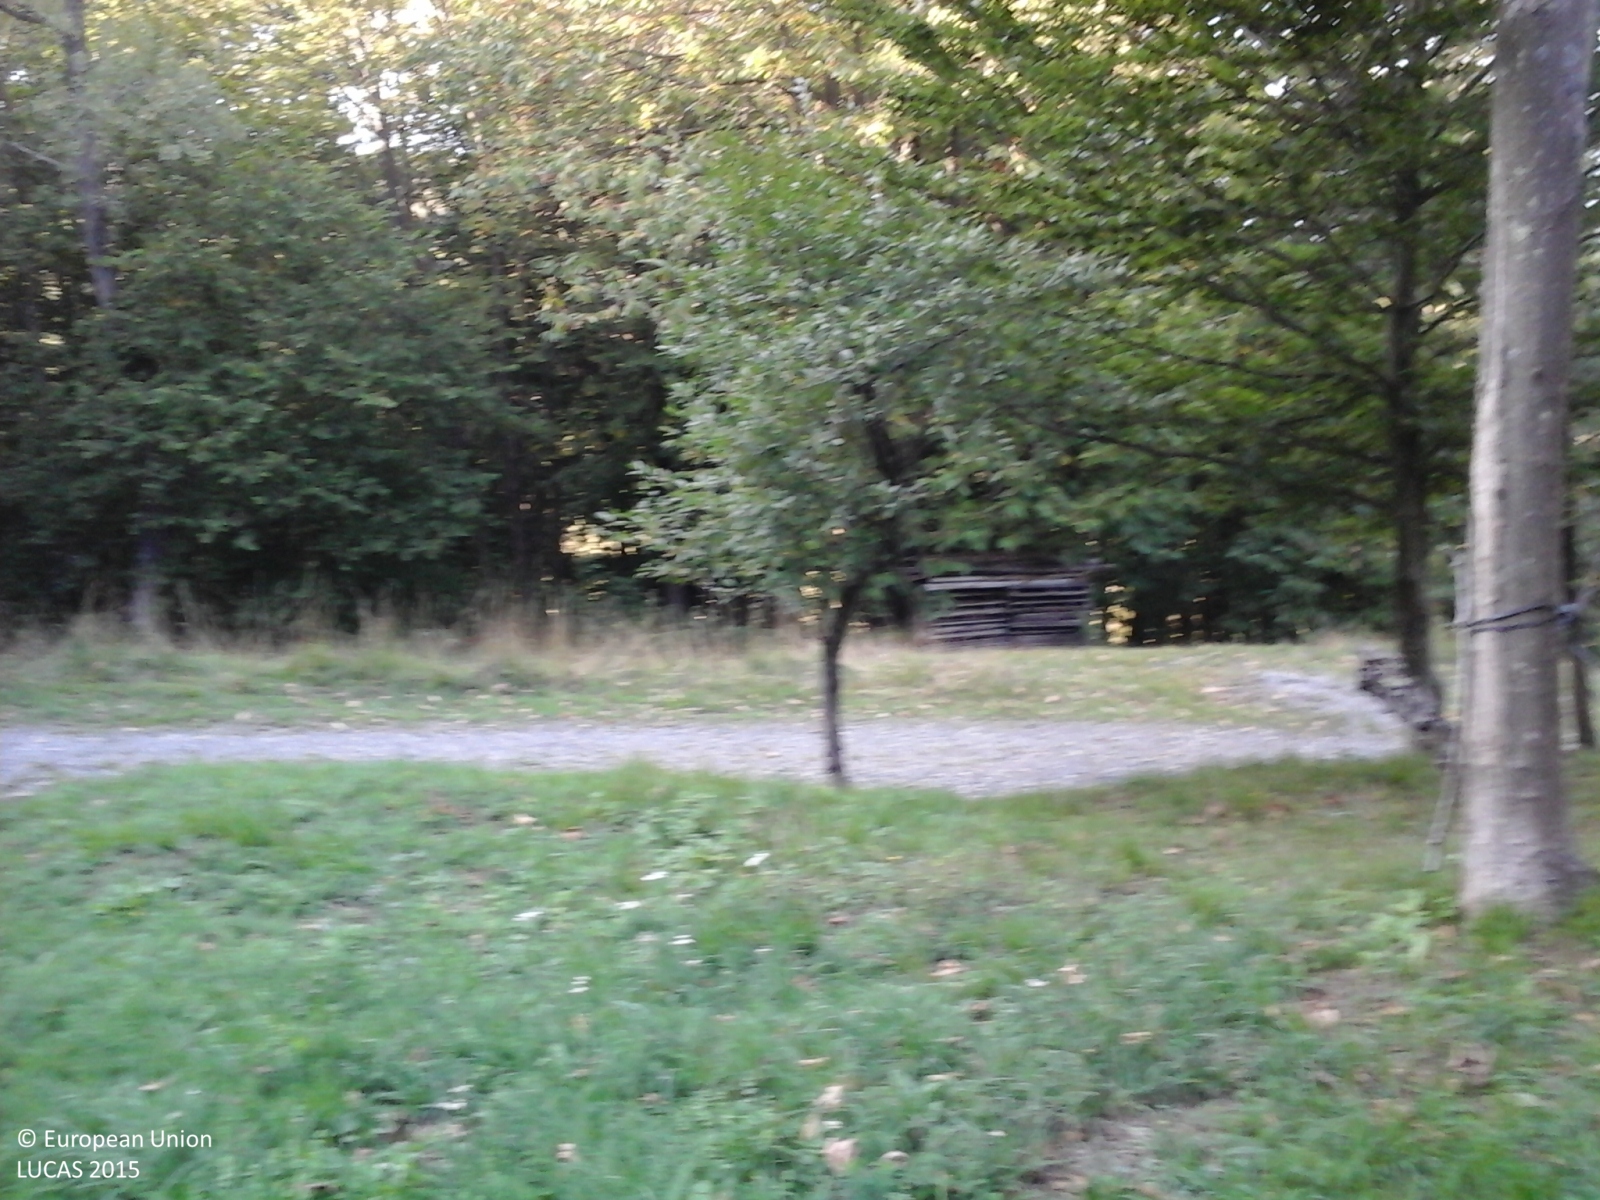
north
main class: Grassland
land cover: Grassland with sparse tree/shrub cover
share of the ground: > 75 %
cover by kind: herbaceous plants 85 %, shrubs 10 %, broadleaved forest trees 5 %
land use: Residential
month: September
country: IT
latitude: 44.4105
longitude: 8.4087
